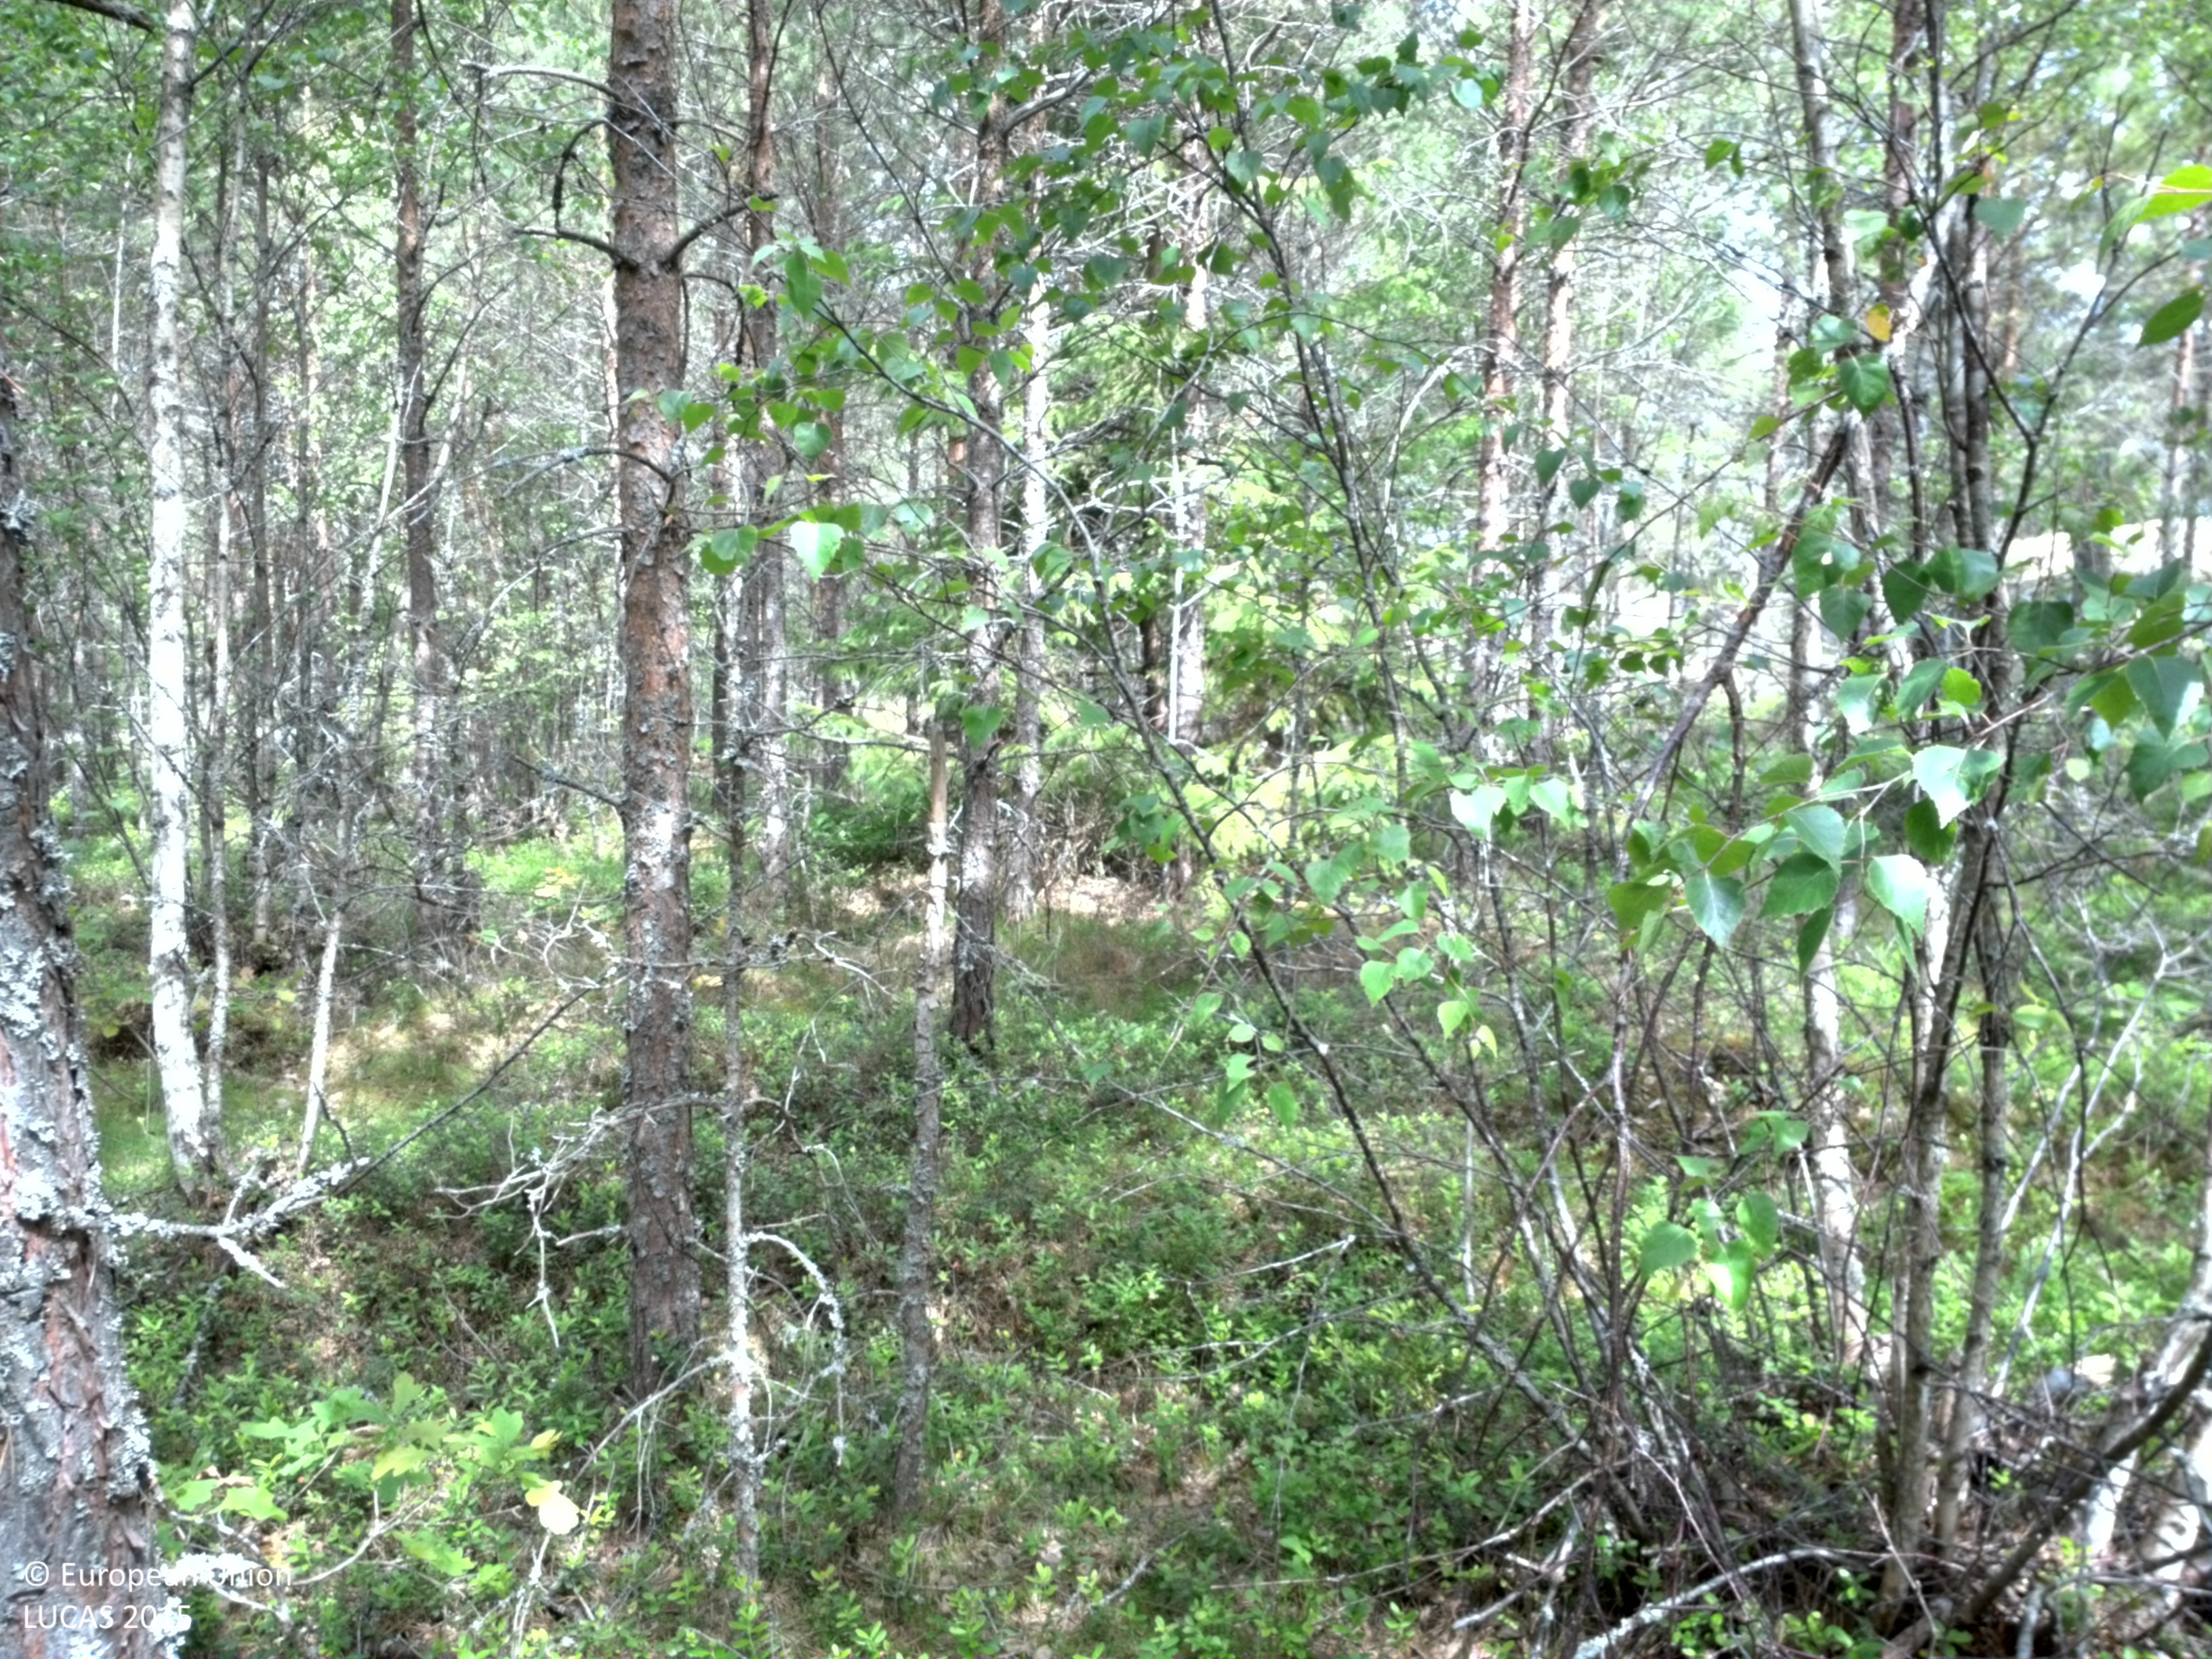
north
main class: Woodland
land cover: Pine dominated coniferous woodland
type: boreal forest
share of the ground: 25 - 50 %
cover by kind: coniferous forest trees 40 %, herbaceous plants 40 %, lichens and mosses 15 %, broadleaved forest trees 5 %
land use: Forestry
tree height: < 5 m
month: June
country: SE
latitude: 58.5295
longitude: 16.1605
